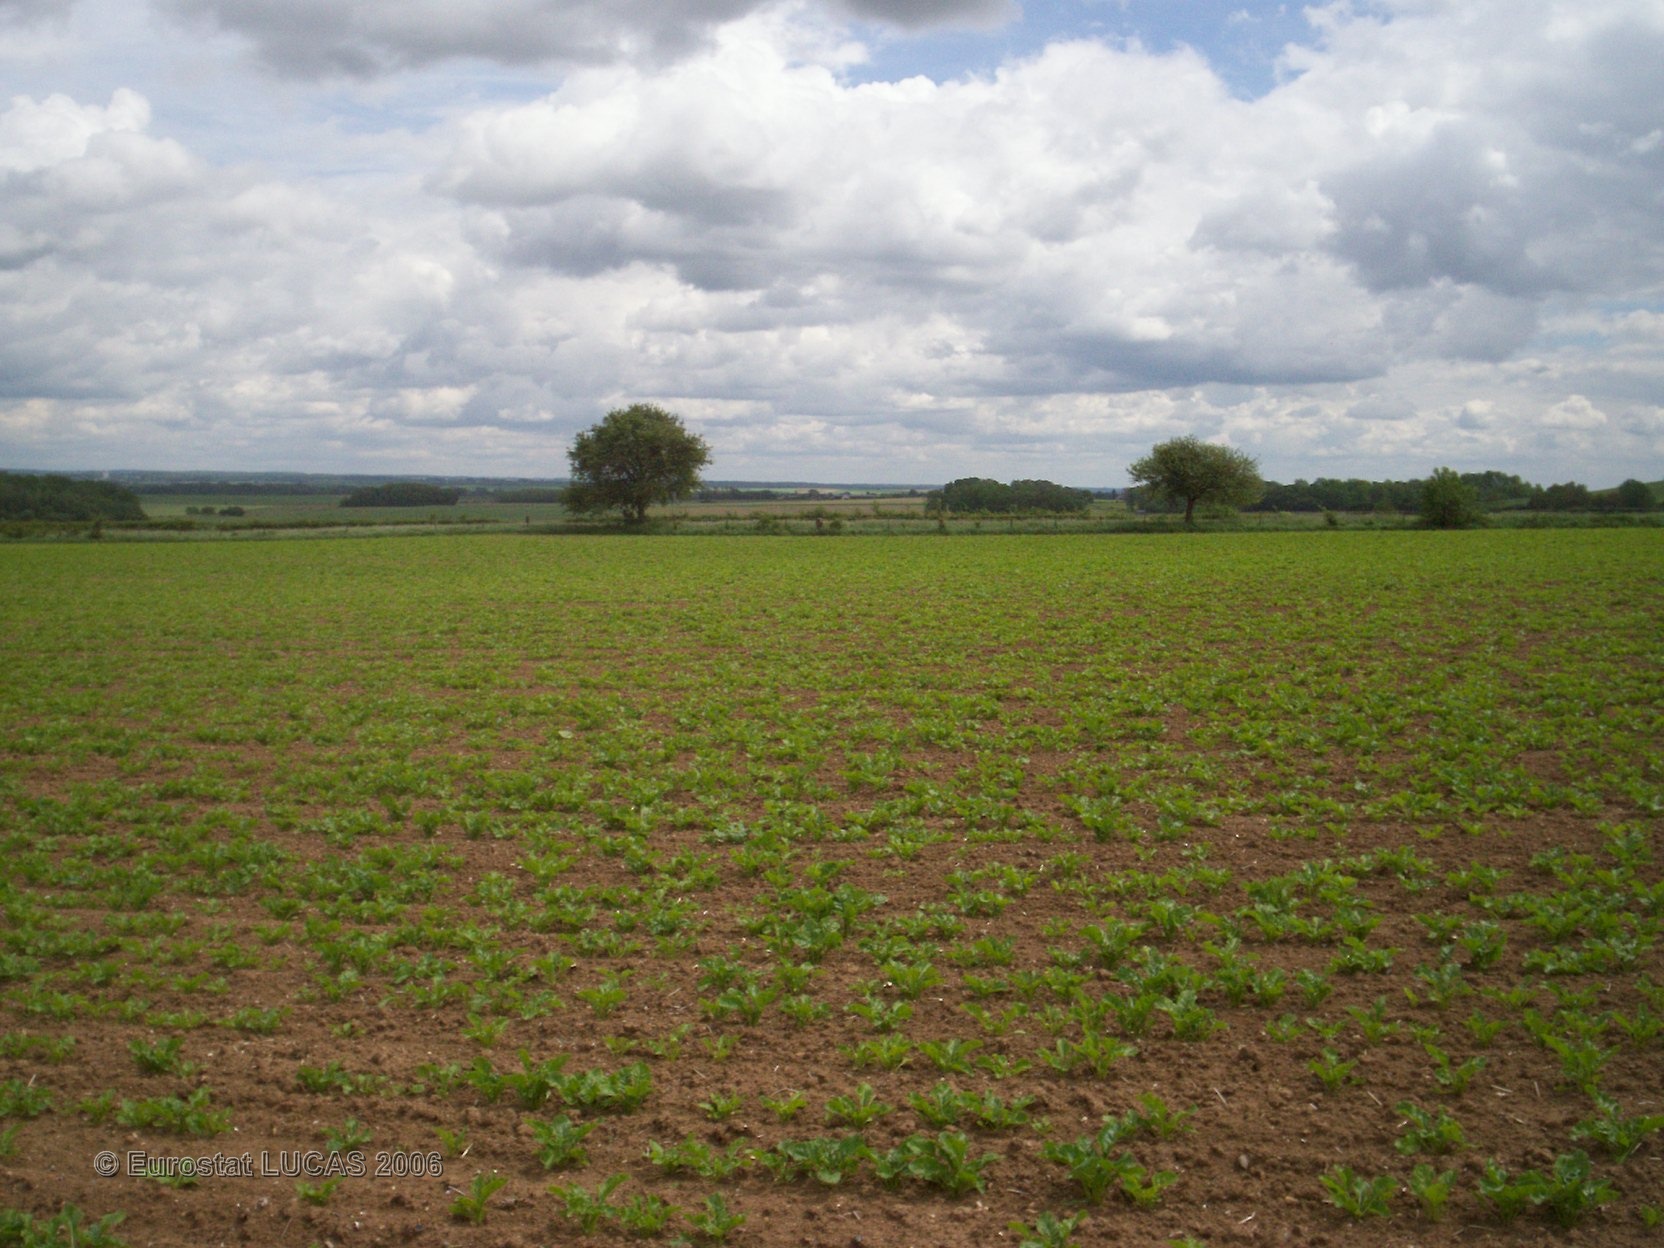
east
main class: Cropland
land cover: Sugar beet
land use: Agriculture (excluding fallow land and kitchen gardens)
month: May
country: FR
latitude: 49.5418
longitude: 4.3989
